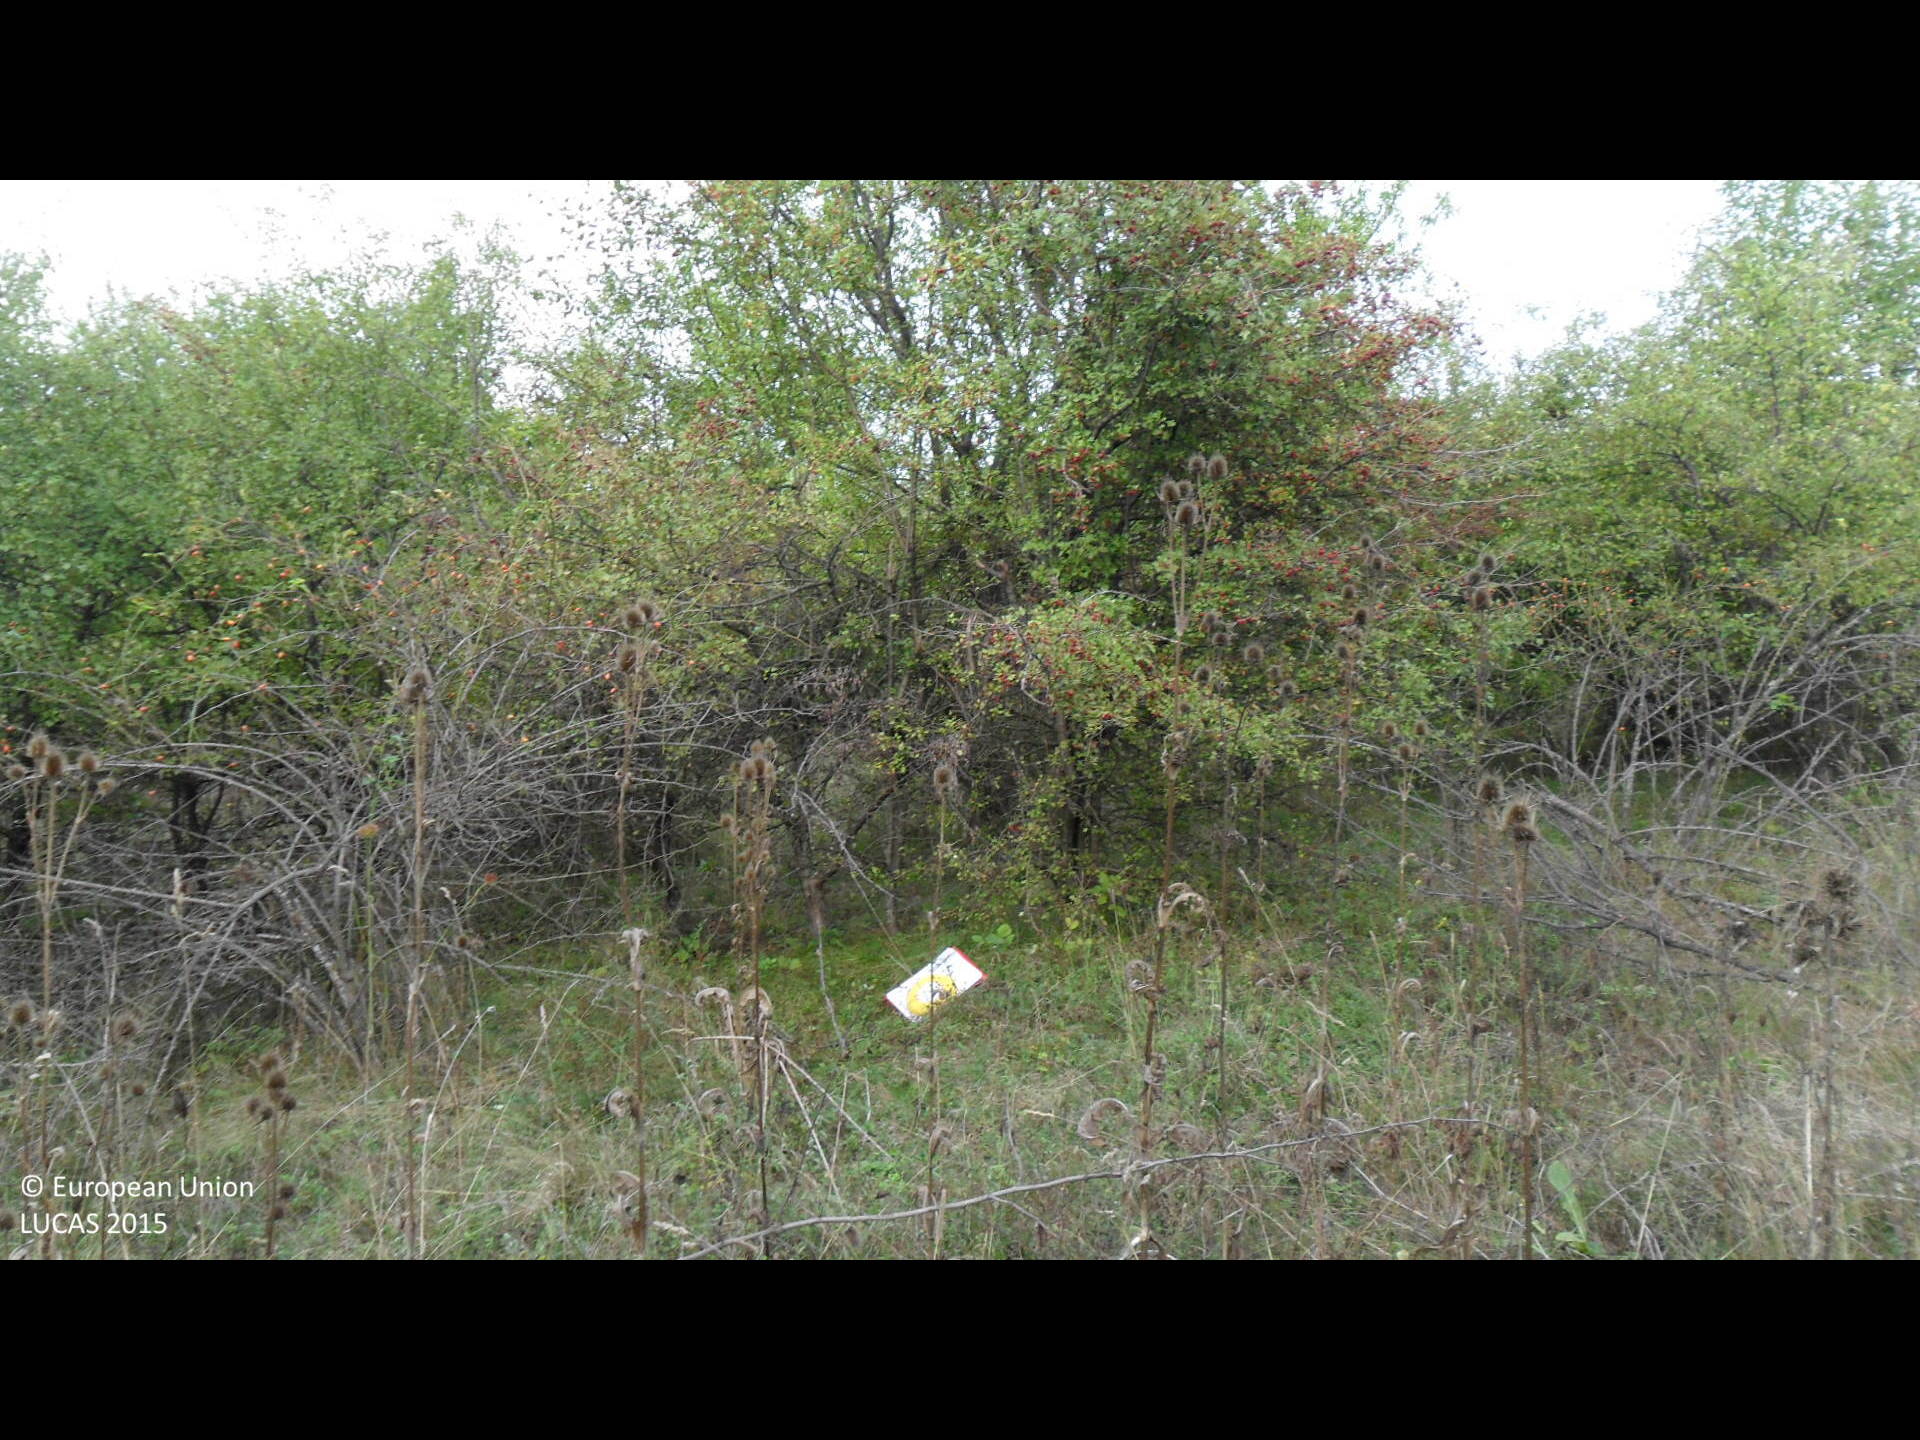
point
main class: Shrubland
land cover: Shrubland with sparse tree cover
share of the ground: > 75 %
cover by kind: shrubs 95 %, broadleaved forest trees 5 %
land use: Agriculture (excluding fallow land and kitchen gardens)
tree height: < 5 m
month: October
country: BG
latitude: 43.0824
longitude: 26.2207
